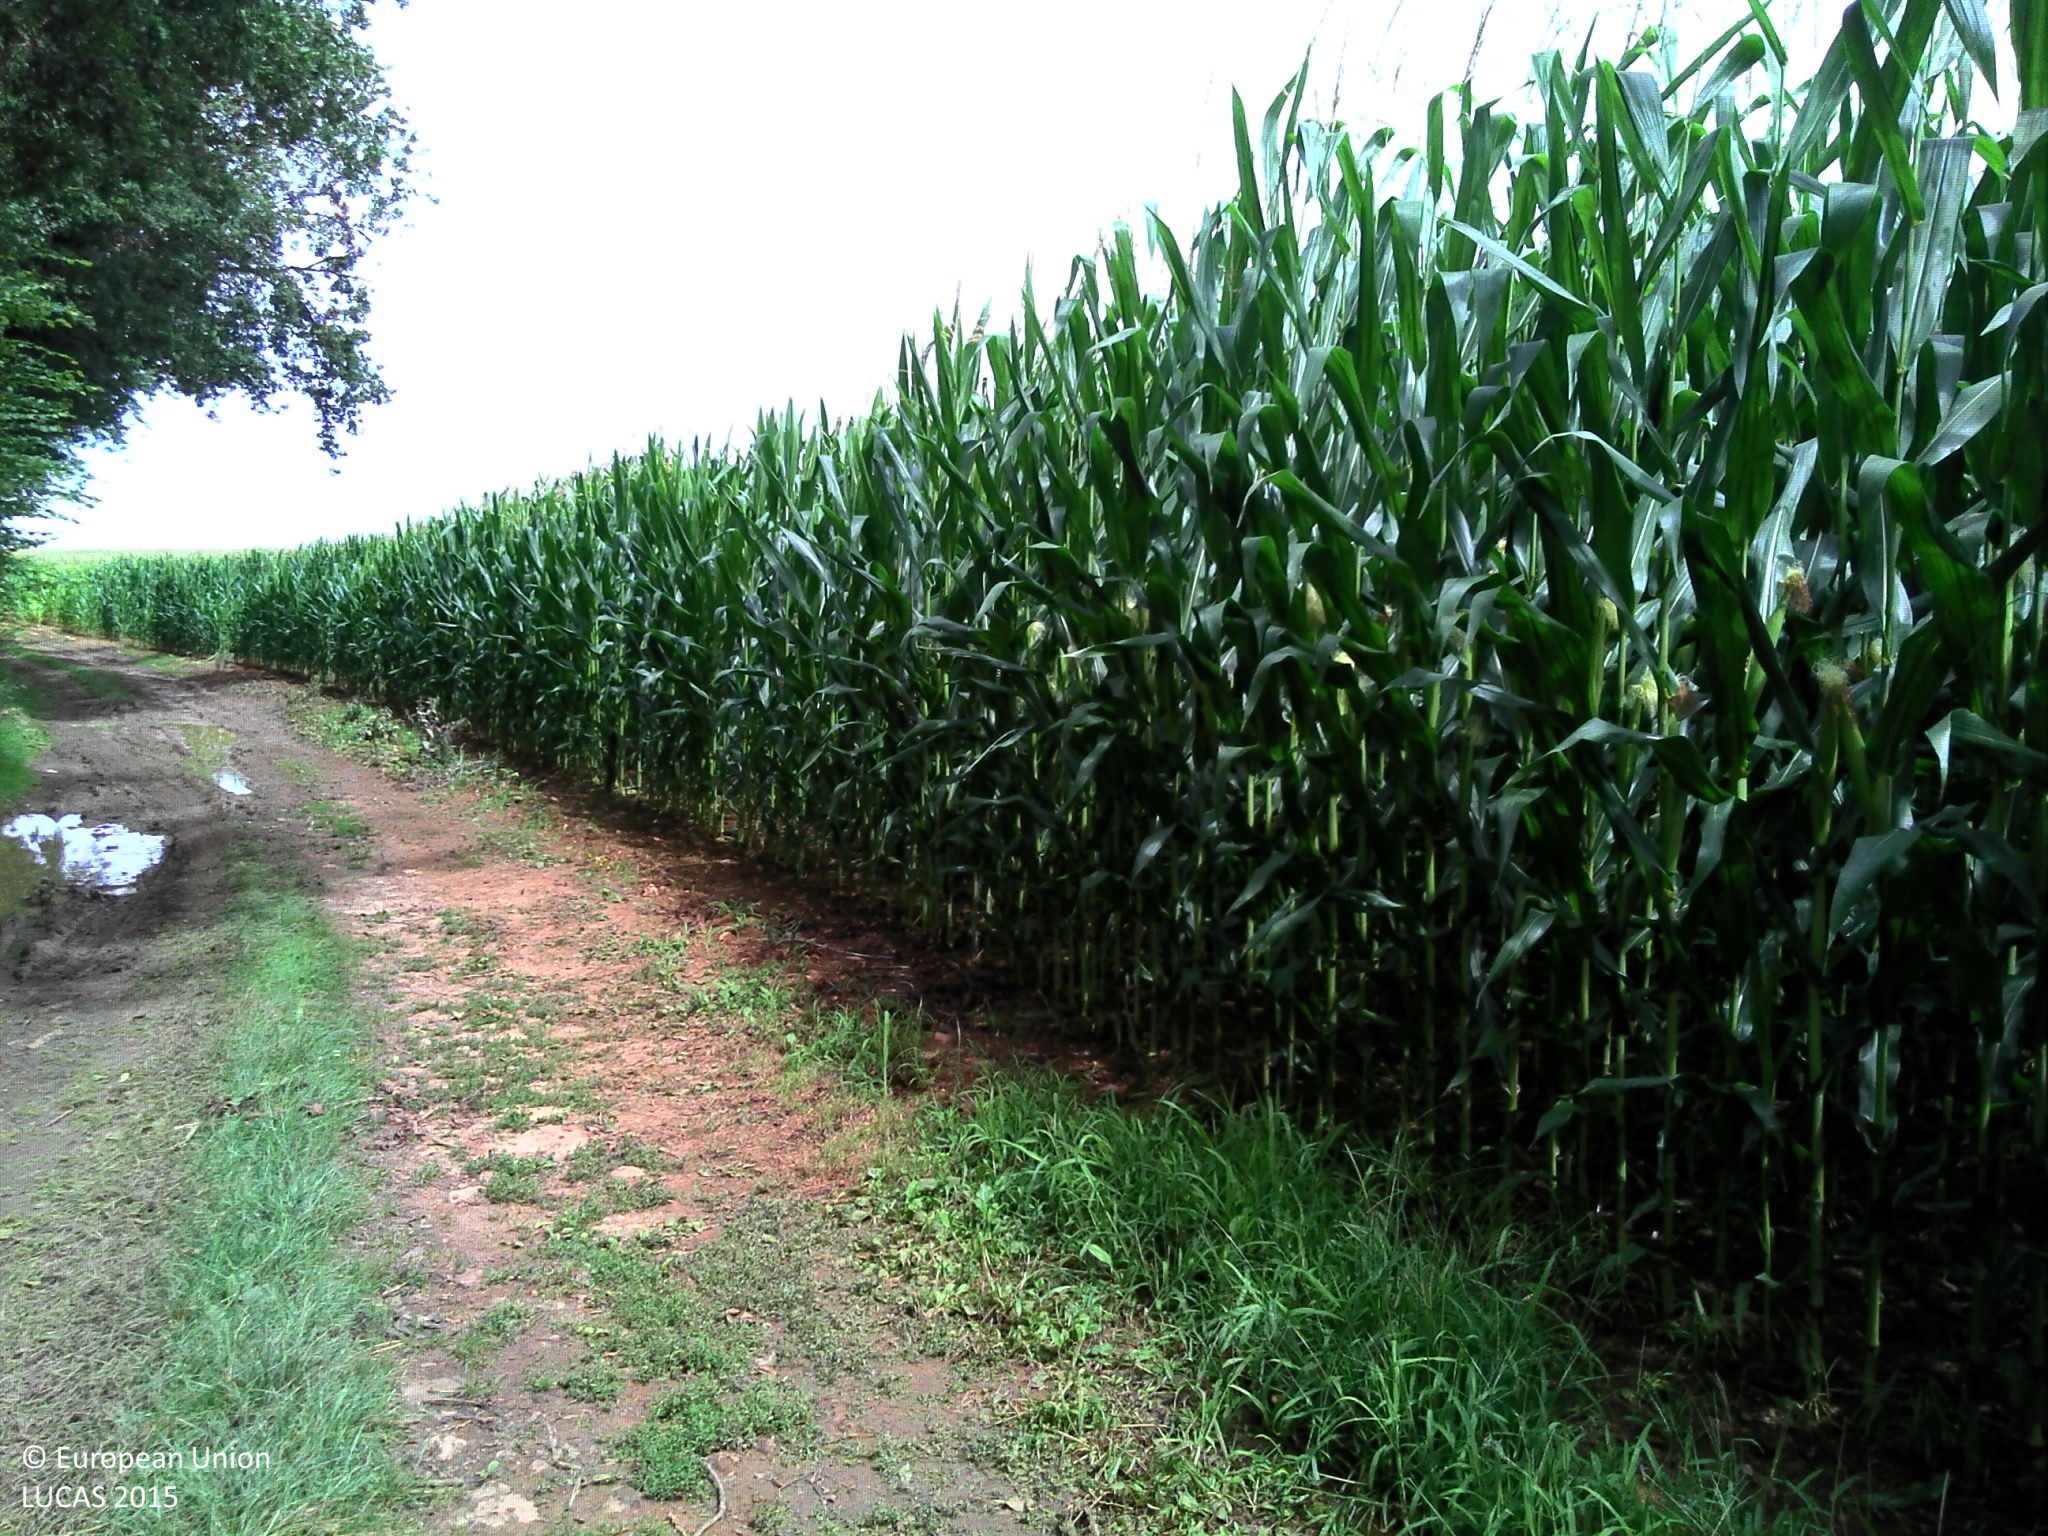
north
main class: Cropland
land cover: Maize
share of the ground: > 75 %
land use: Agriculture (excluding fallow land and kitchen gardens)
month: July
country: FR
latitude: 46.3781
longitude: 0.2693
